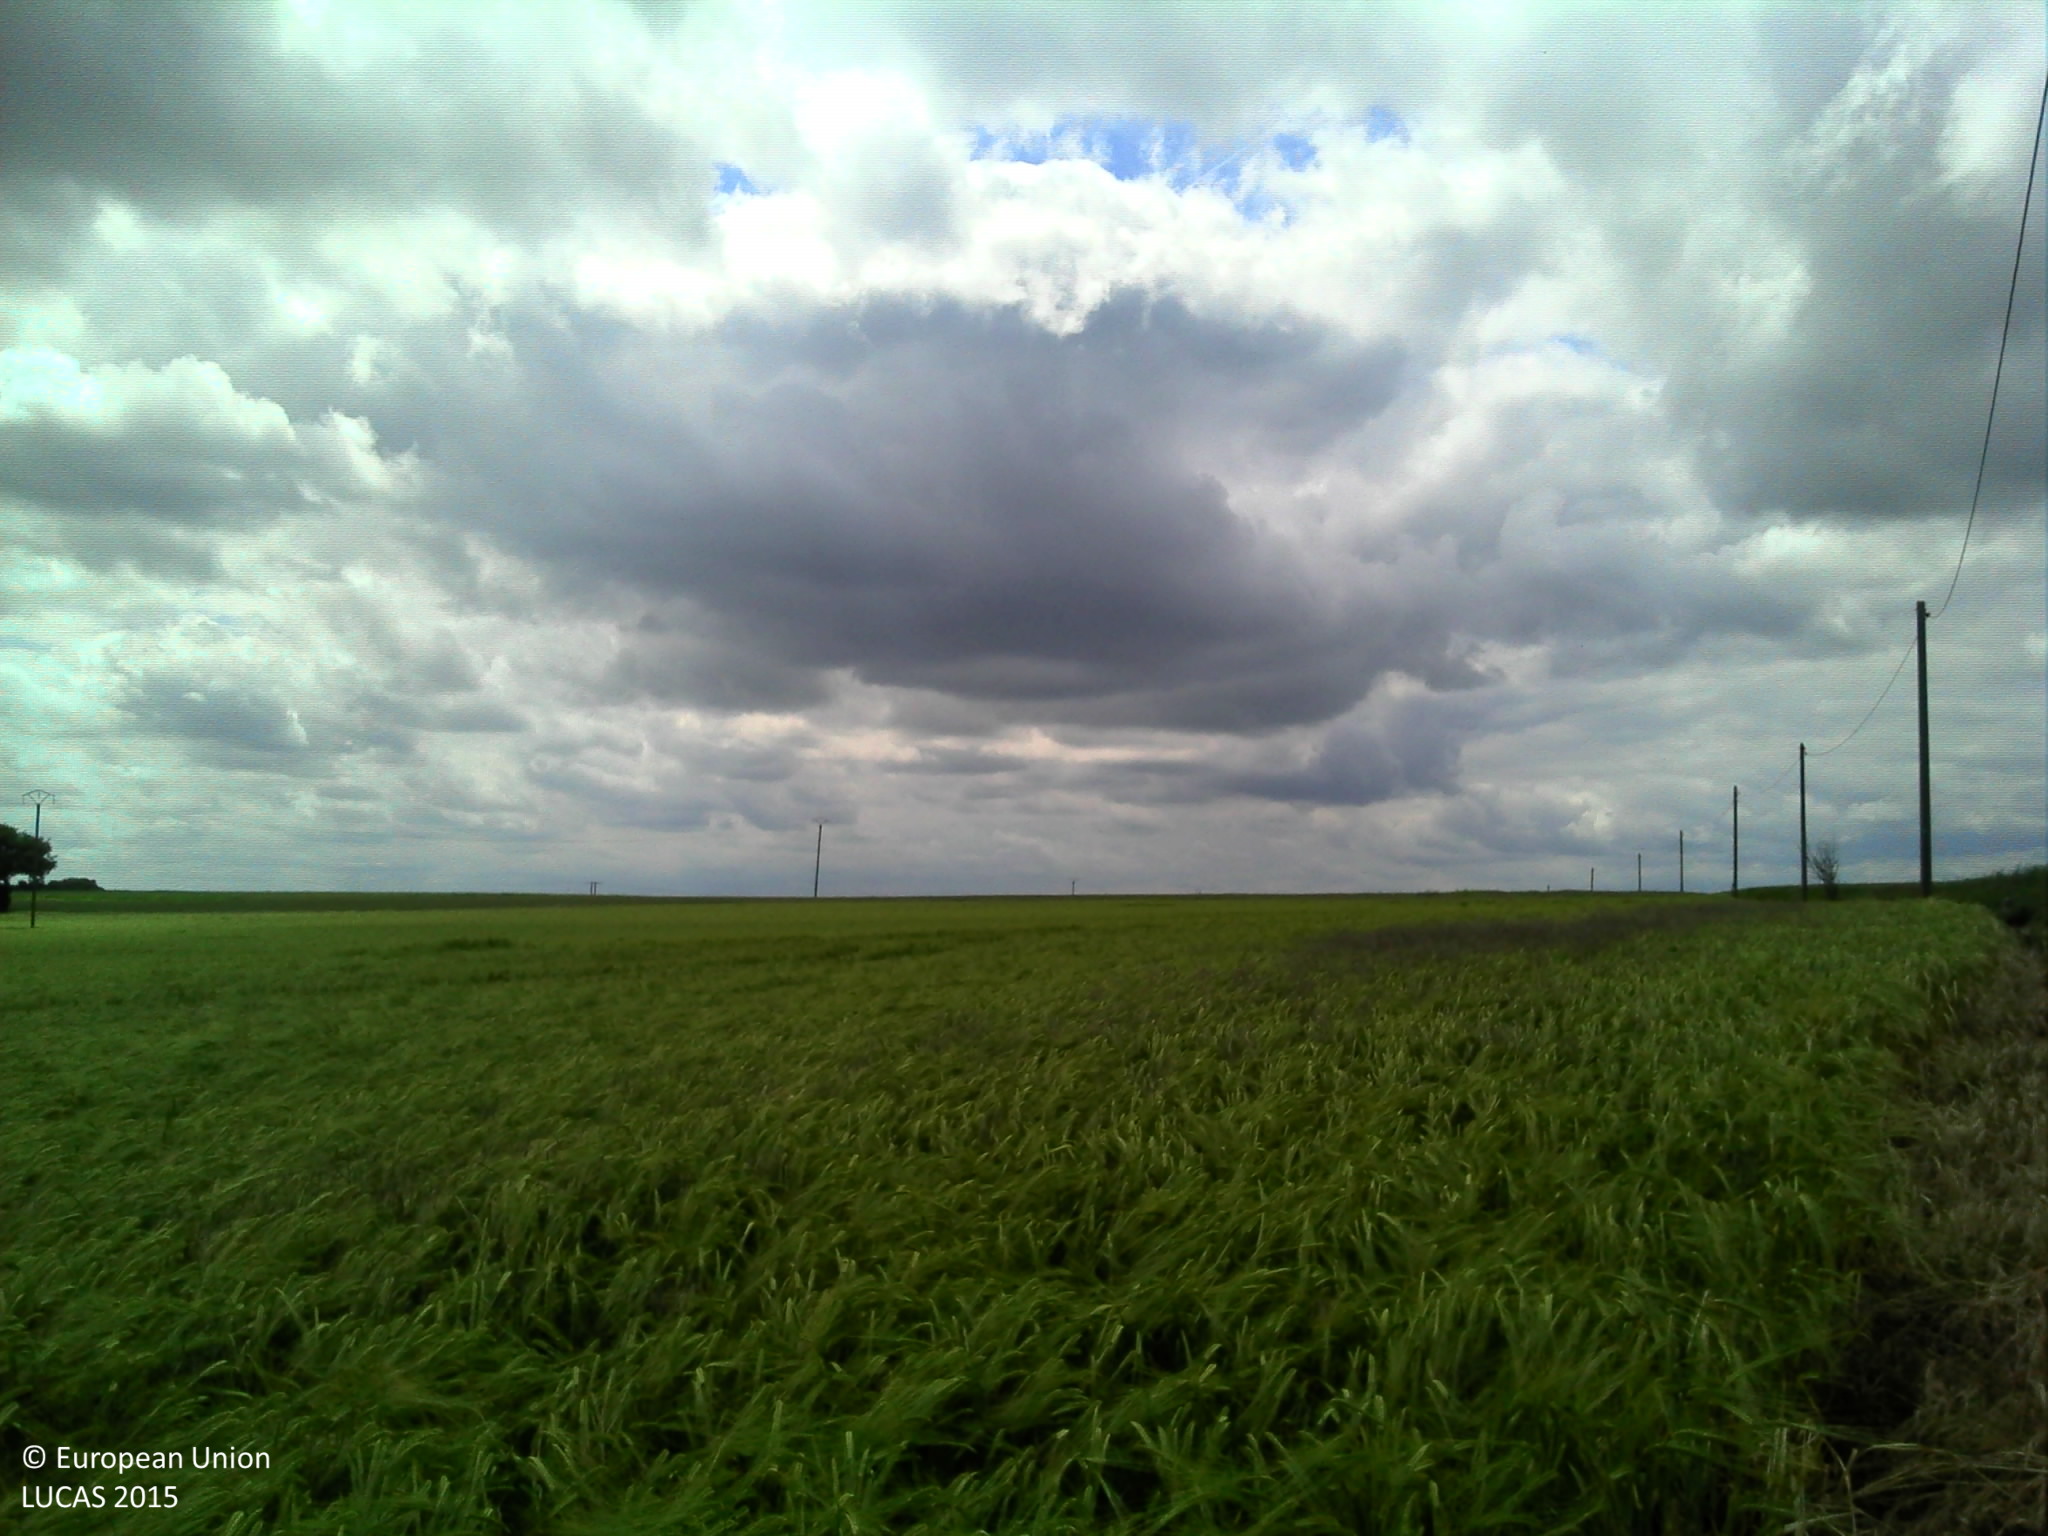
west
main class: Cropland
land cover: Barley
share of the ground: > 75 %
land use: Agriculture (excluding fallow land and kitchen gardens)
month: May
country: FR
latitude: 48.0759
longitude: -0.0009
